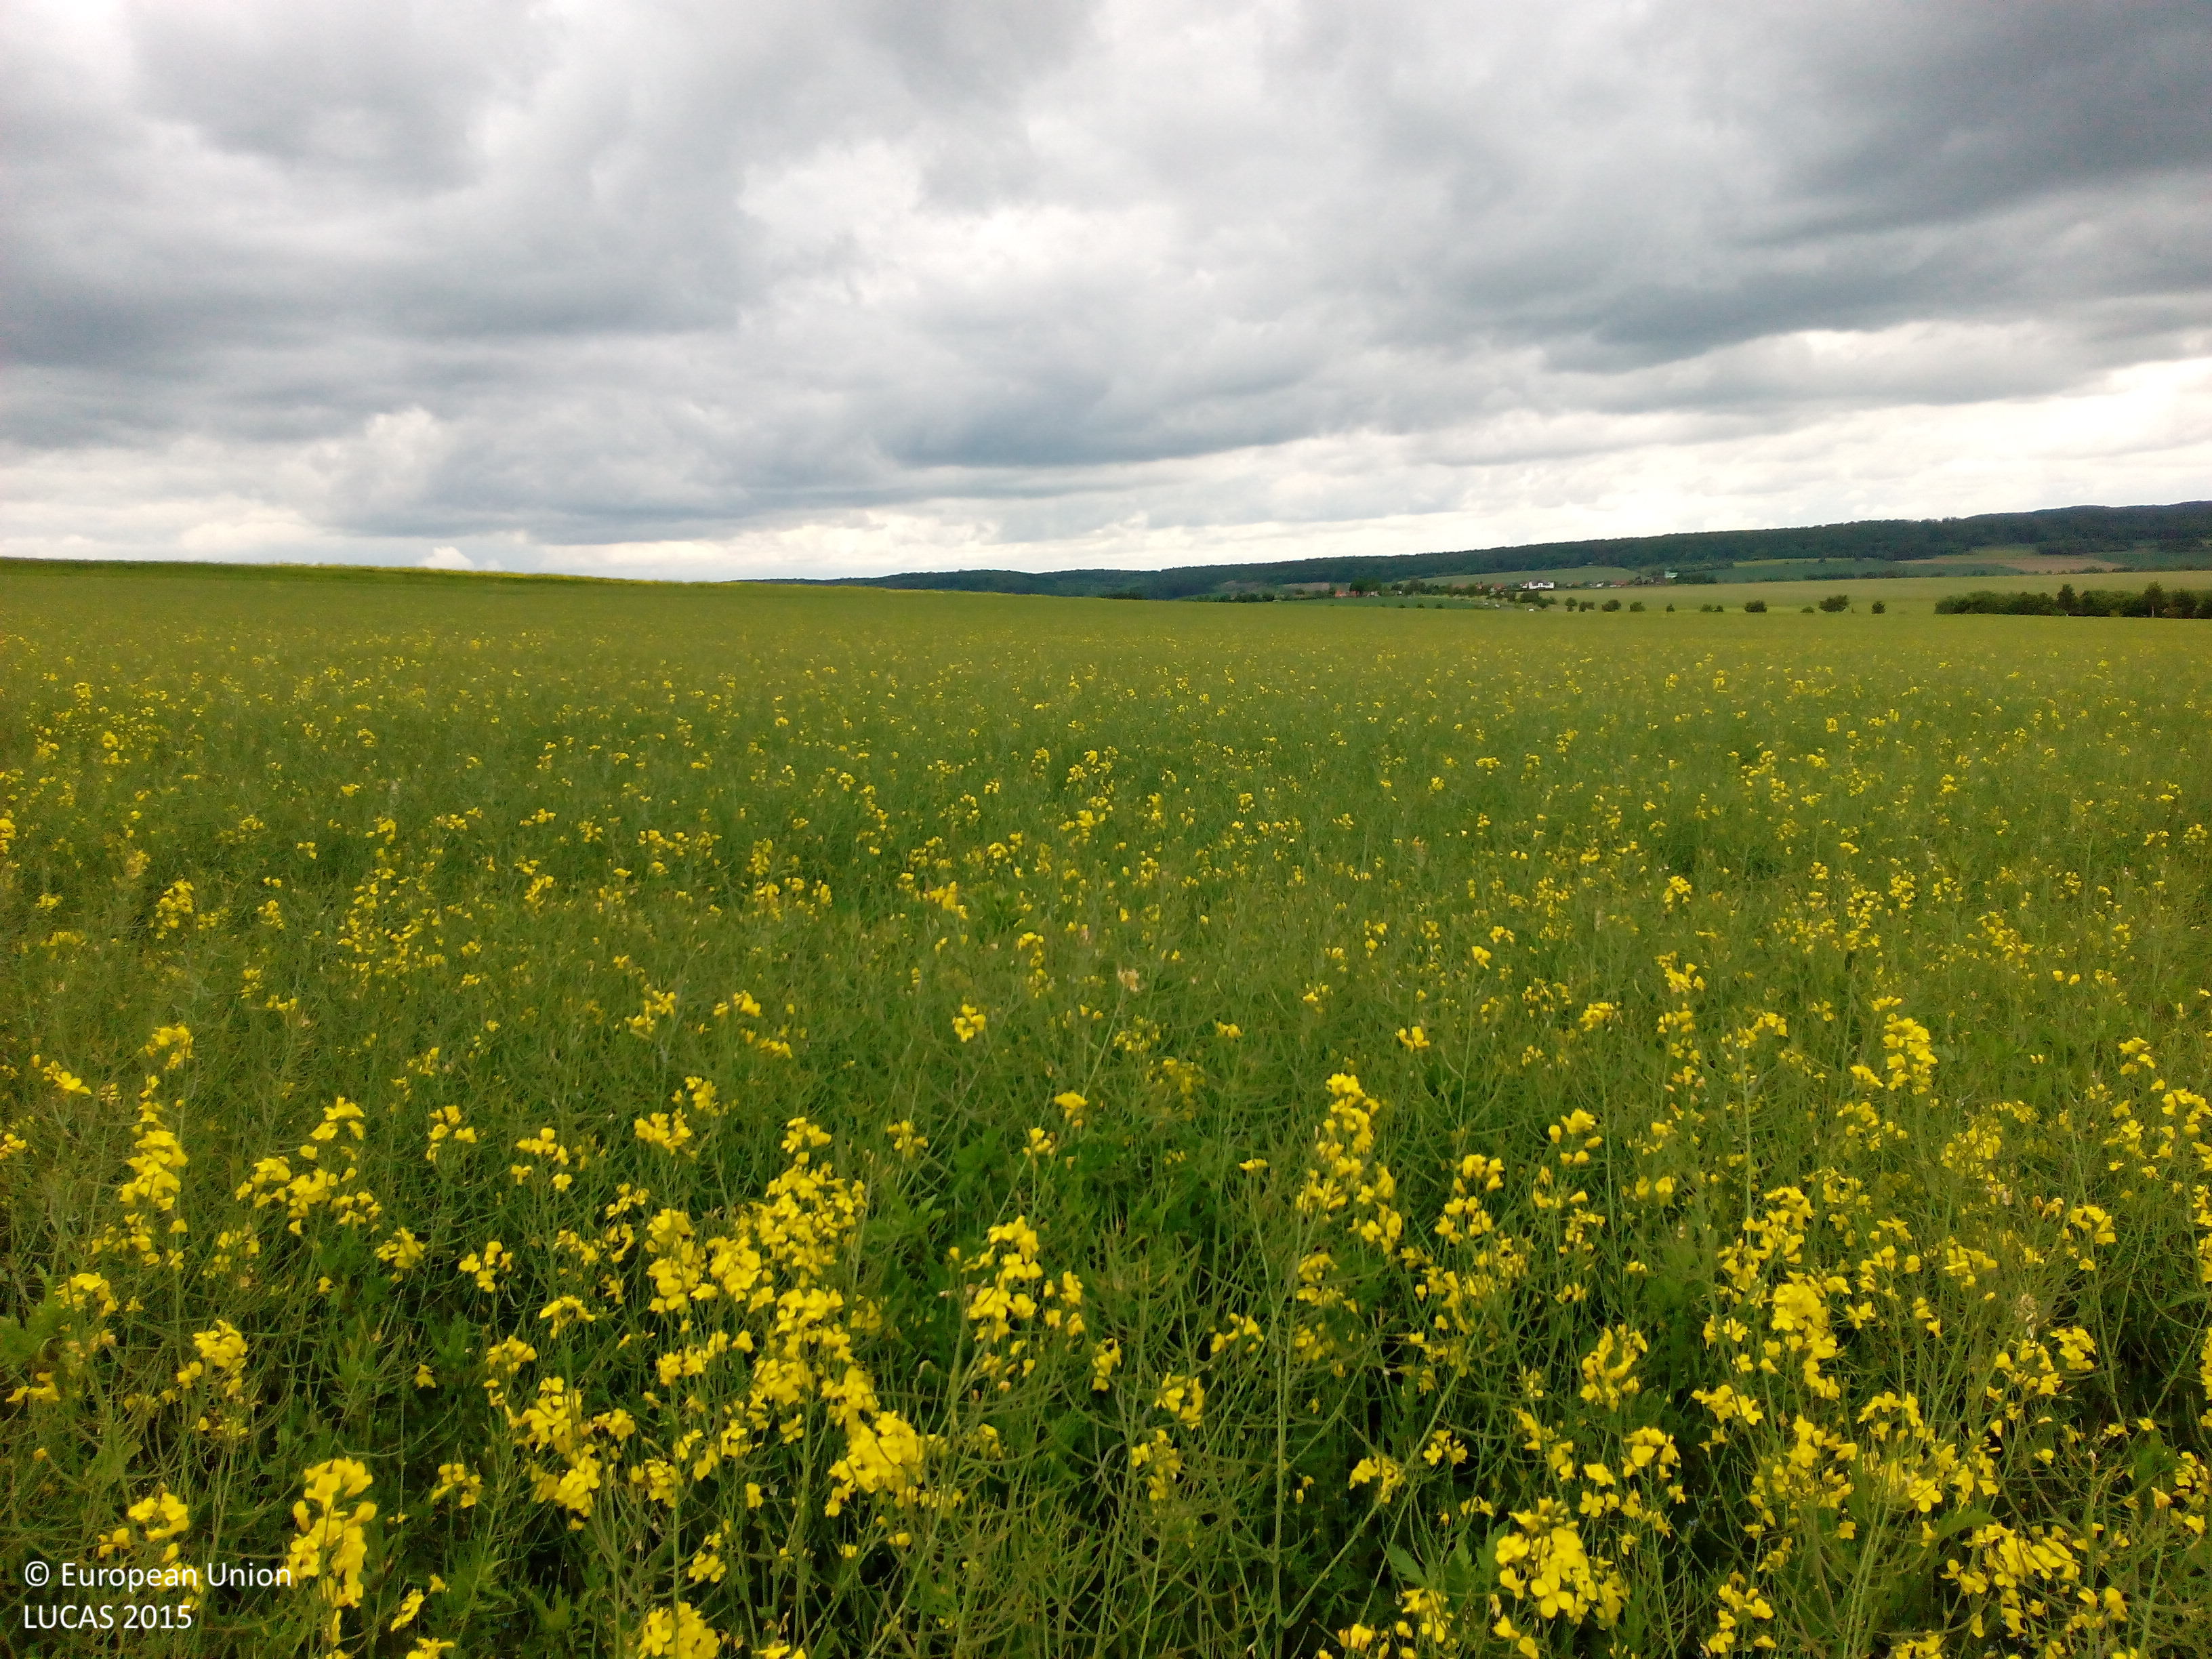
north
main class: Cropland
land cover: Rape and turnip rape
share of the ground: > 75 %
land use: Agriculture (excluding fallow land and kitchen gardens)
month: May
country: DE
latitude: 52.0359
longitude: 9.8980
